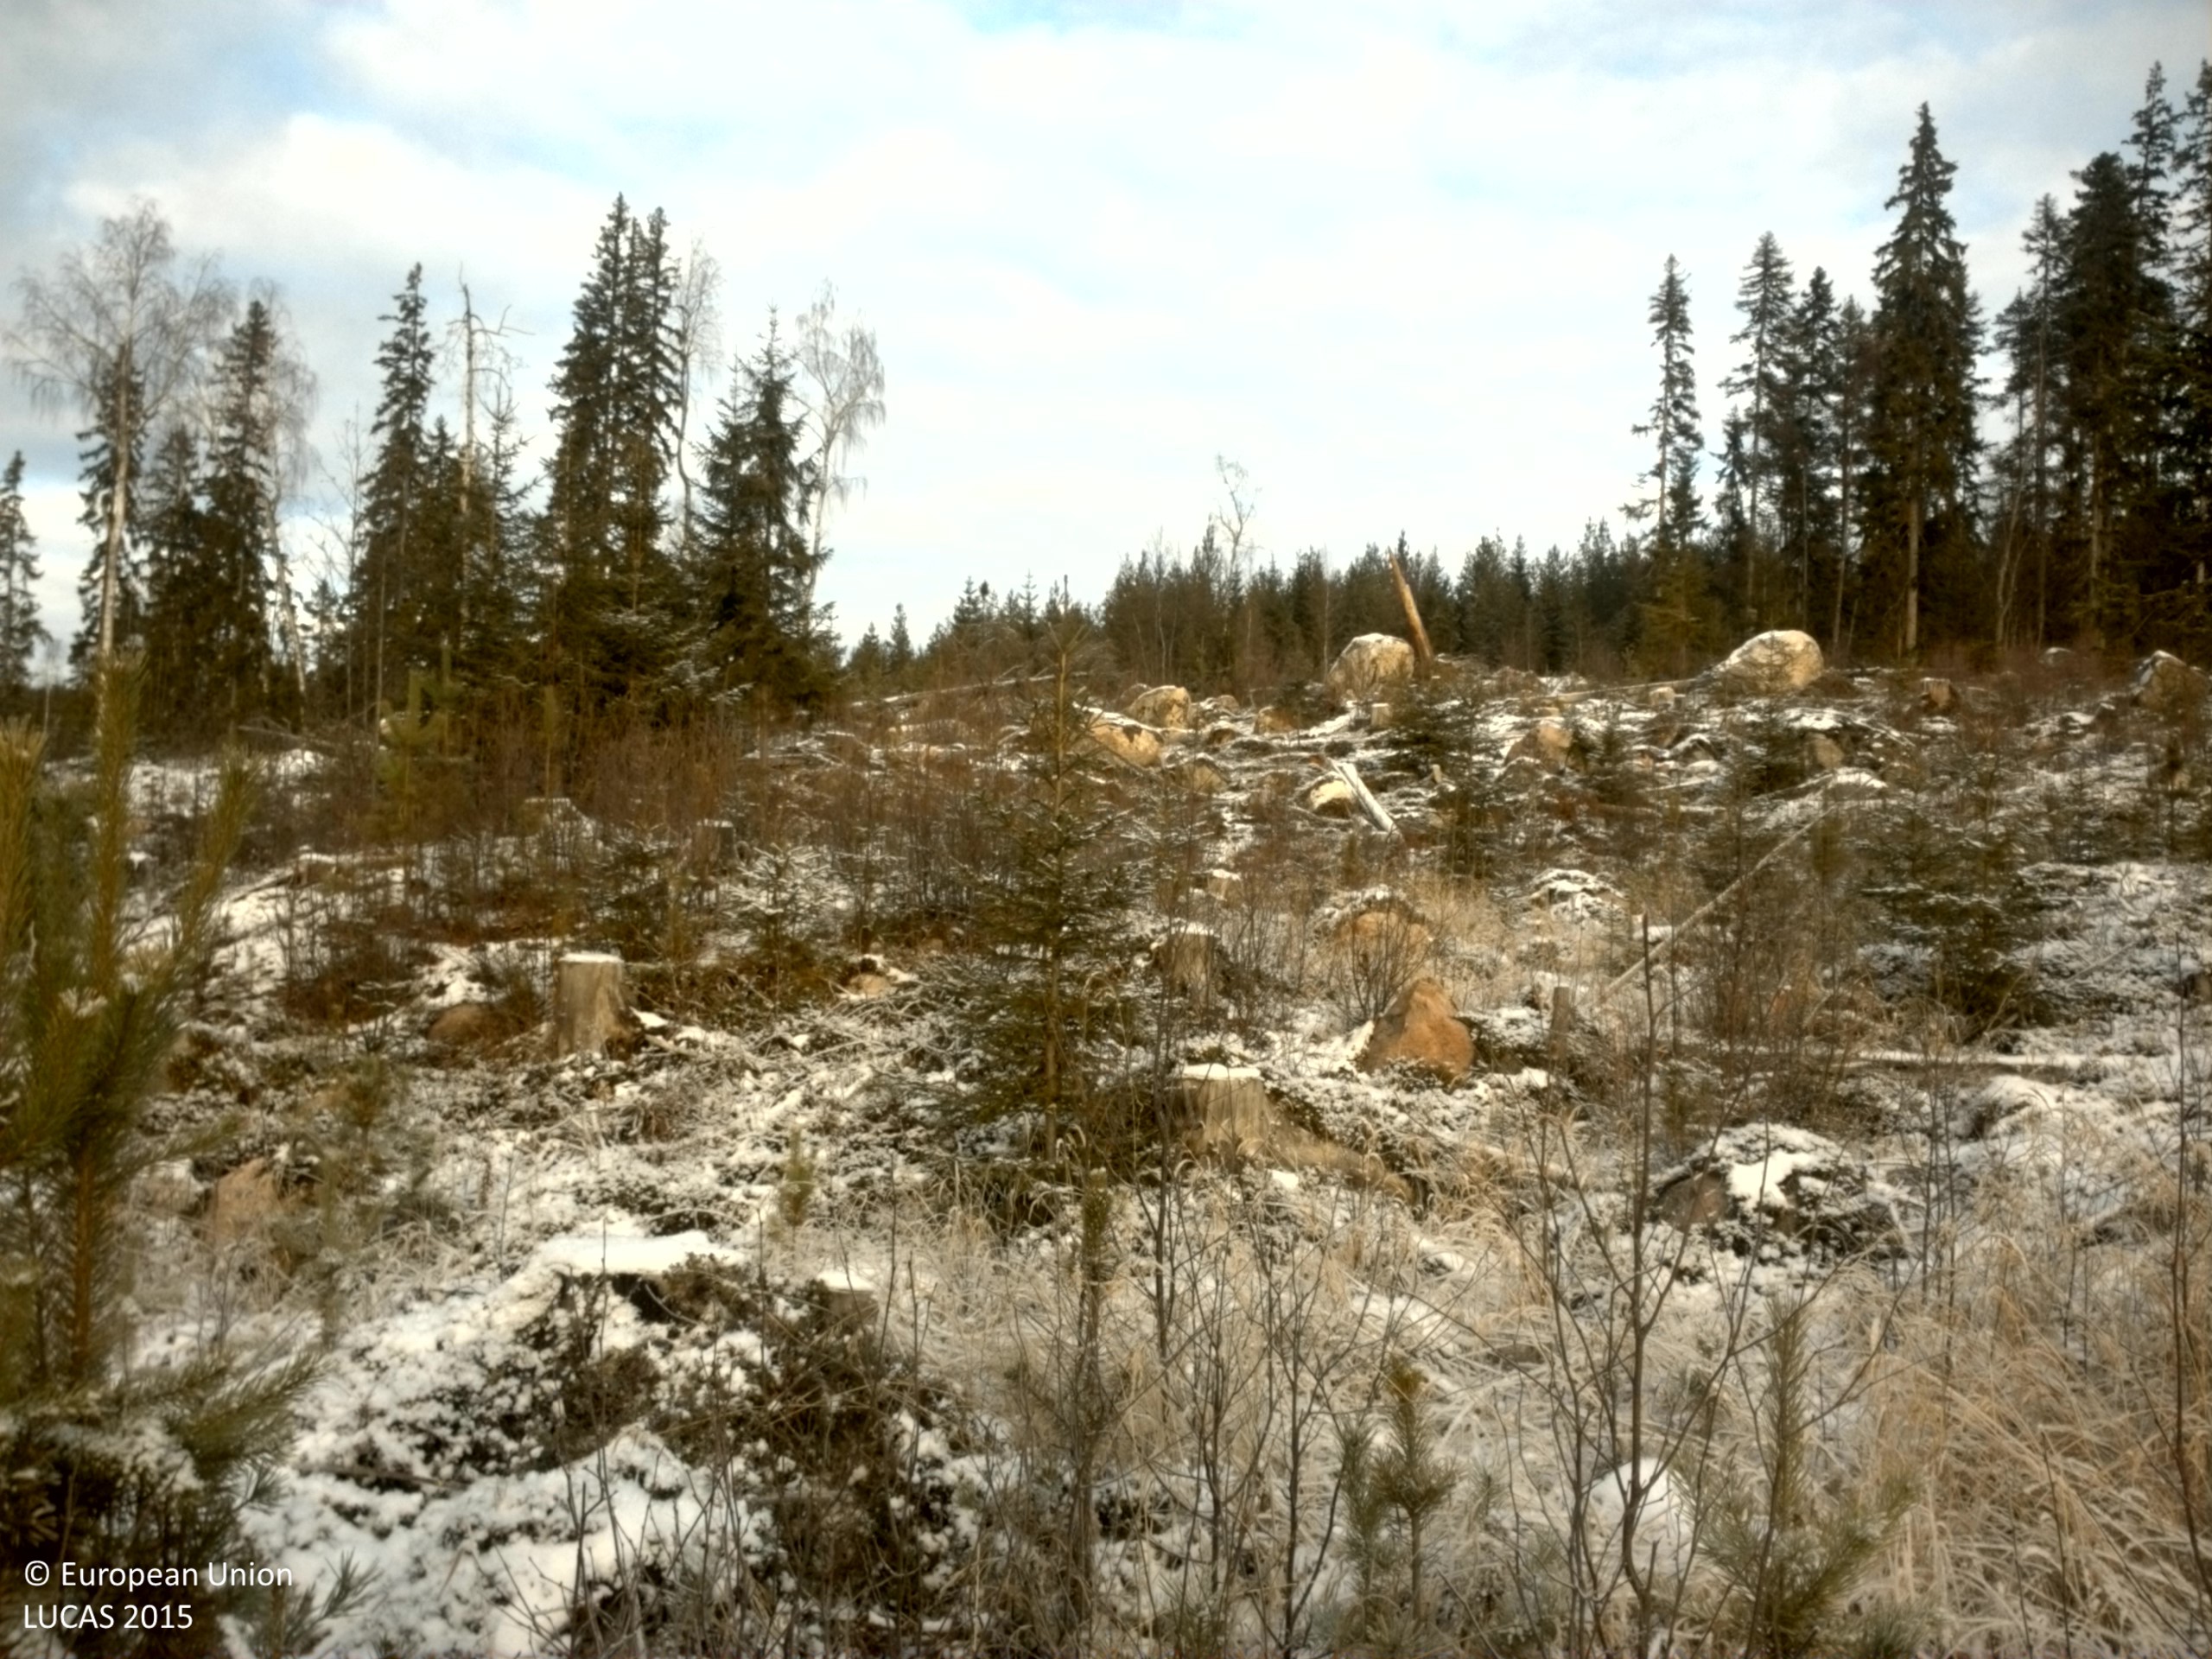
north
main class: Woodland
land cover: Other mixed woodland
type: boreal forest
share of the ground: 25 - 50 %
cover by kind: shrubs 40 %, lichens and mosses 25 %, broadleaved forest trees 20 %, coniferous forest trees 15 %
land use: Forestry
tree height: < 5 m
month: November
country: SE
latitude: 62.0127
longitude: 15.3114
